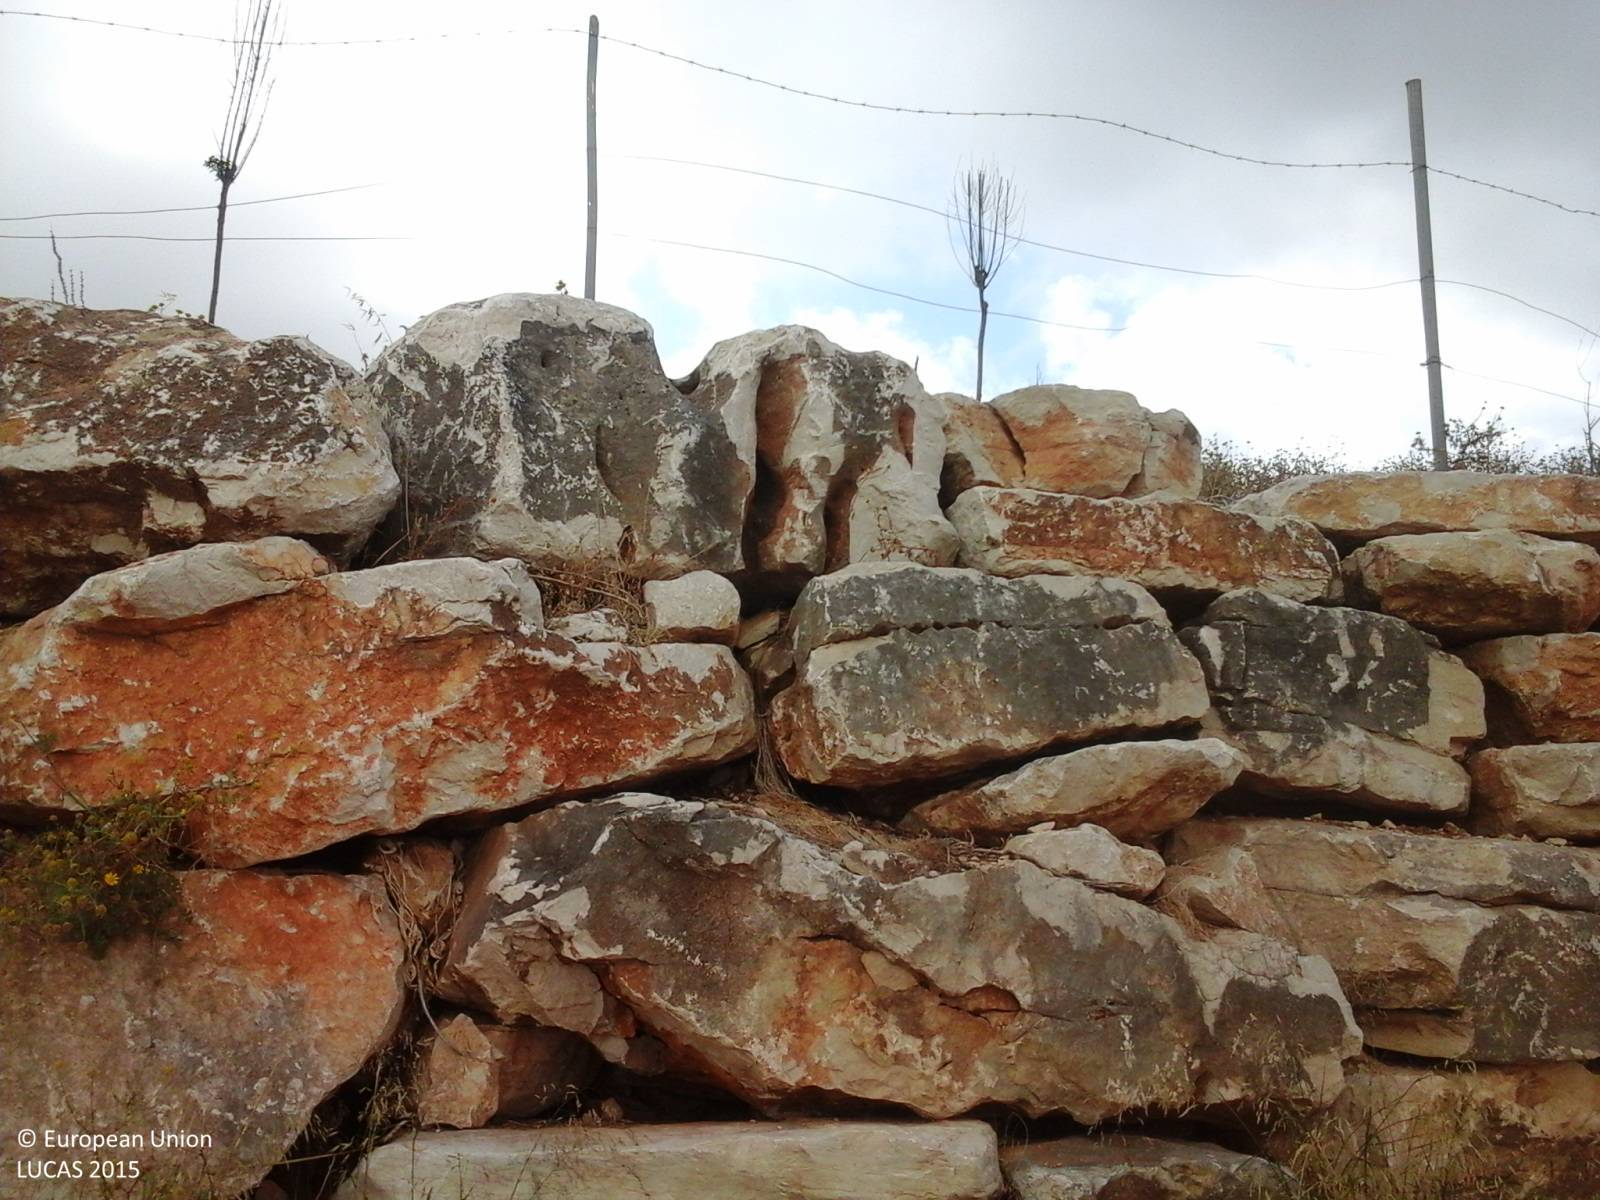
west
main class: Grassland
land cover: Spontaneously vegetated surfaces
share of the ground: > 75 %
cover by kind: herbaceous plants 100 %
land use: Fallow land
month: June
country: IT
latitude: 38.0554
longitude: 12.6591
